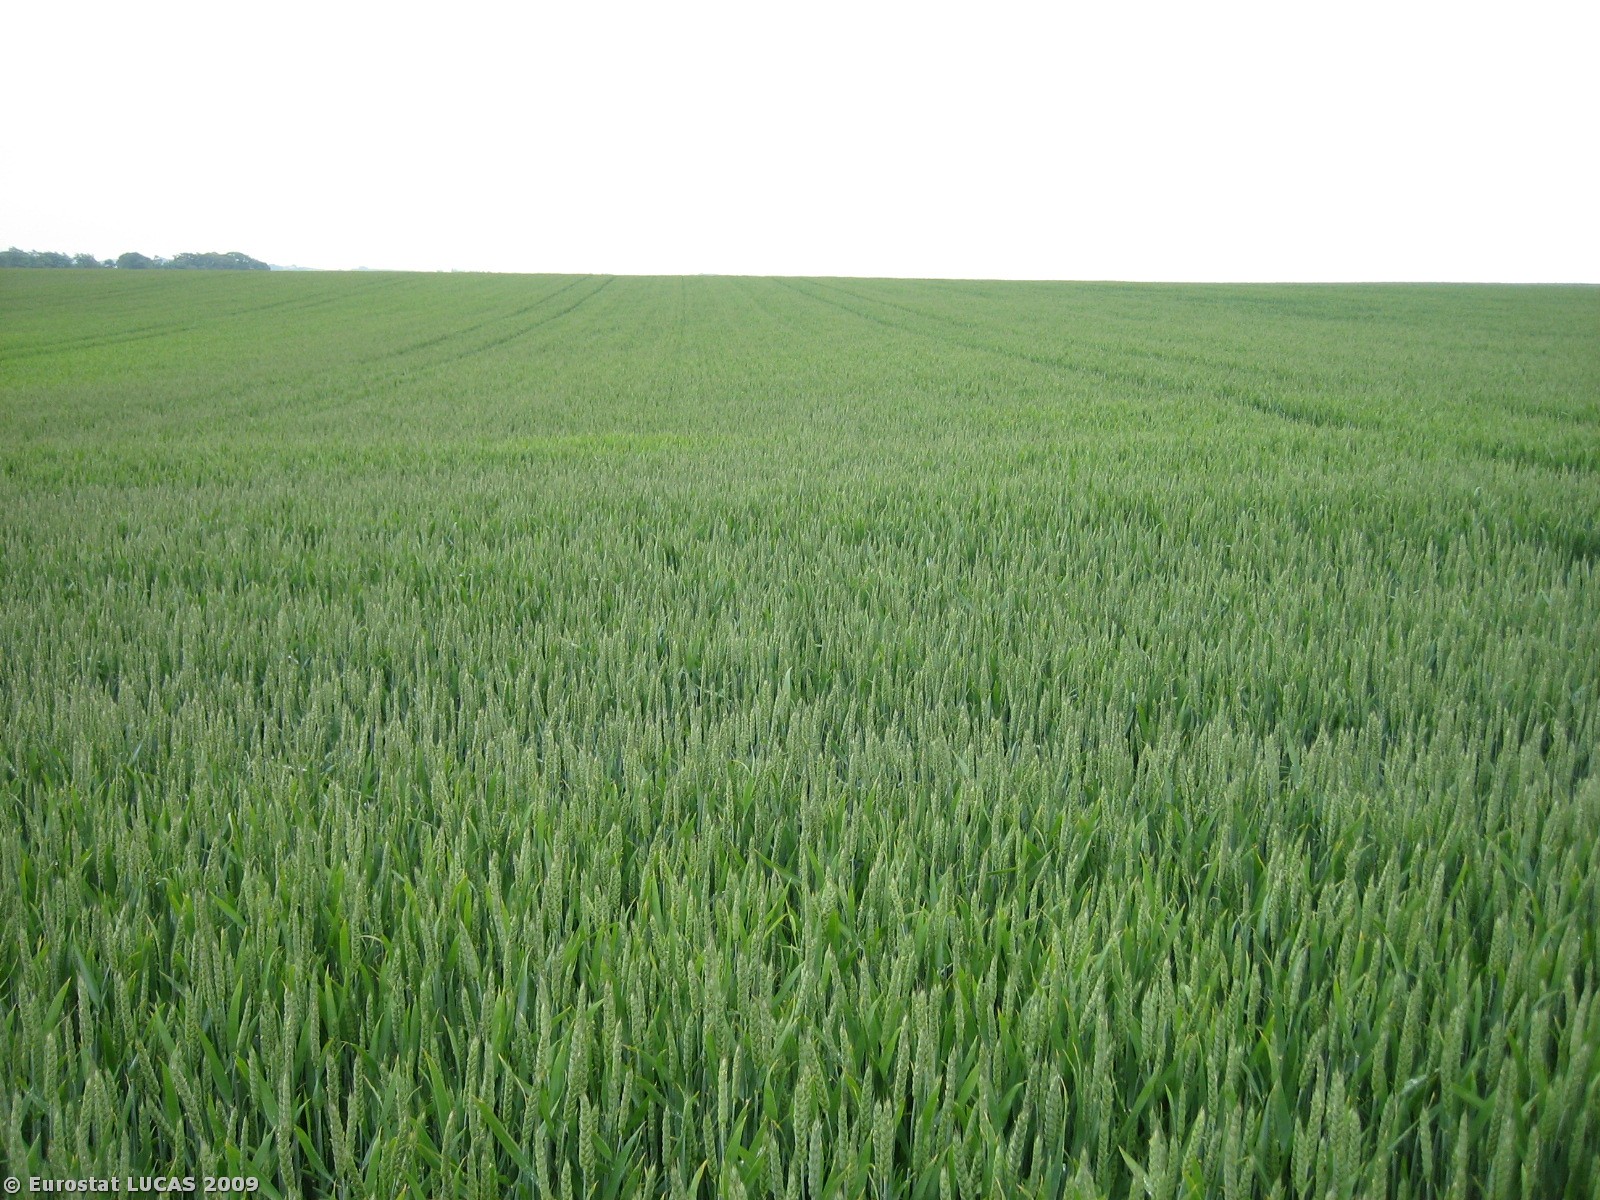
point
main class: Cropland
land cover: Common wheat
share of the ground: > 75 %
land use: Agriculture (excluding fallow land and kitchen gardens)
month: June
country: DK
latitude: 56.1518
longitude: 10.0161
